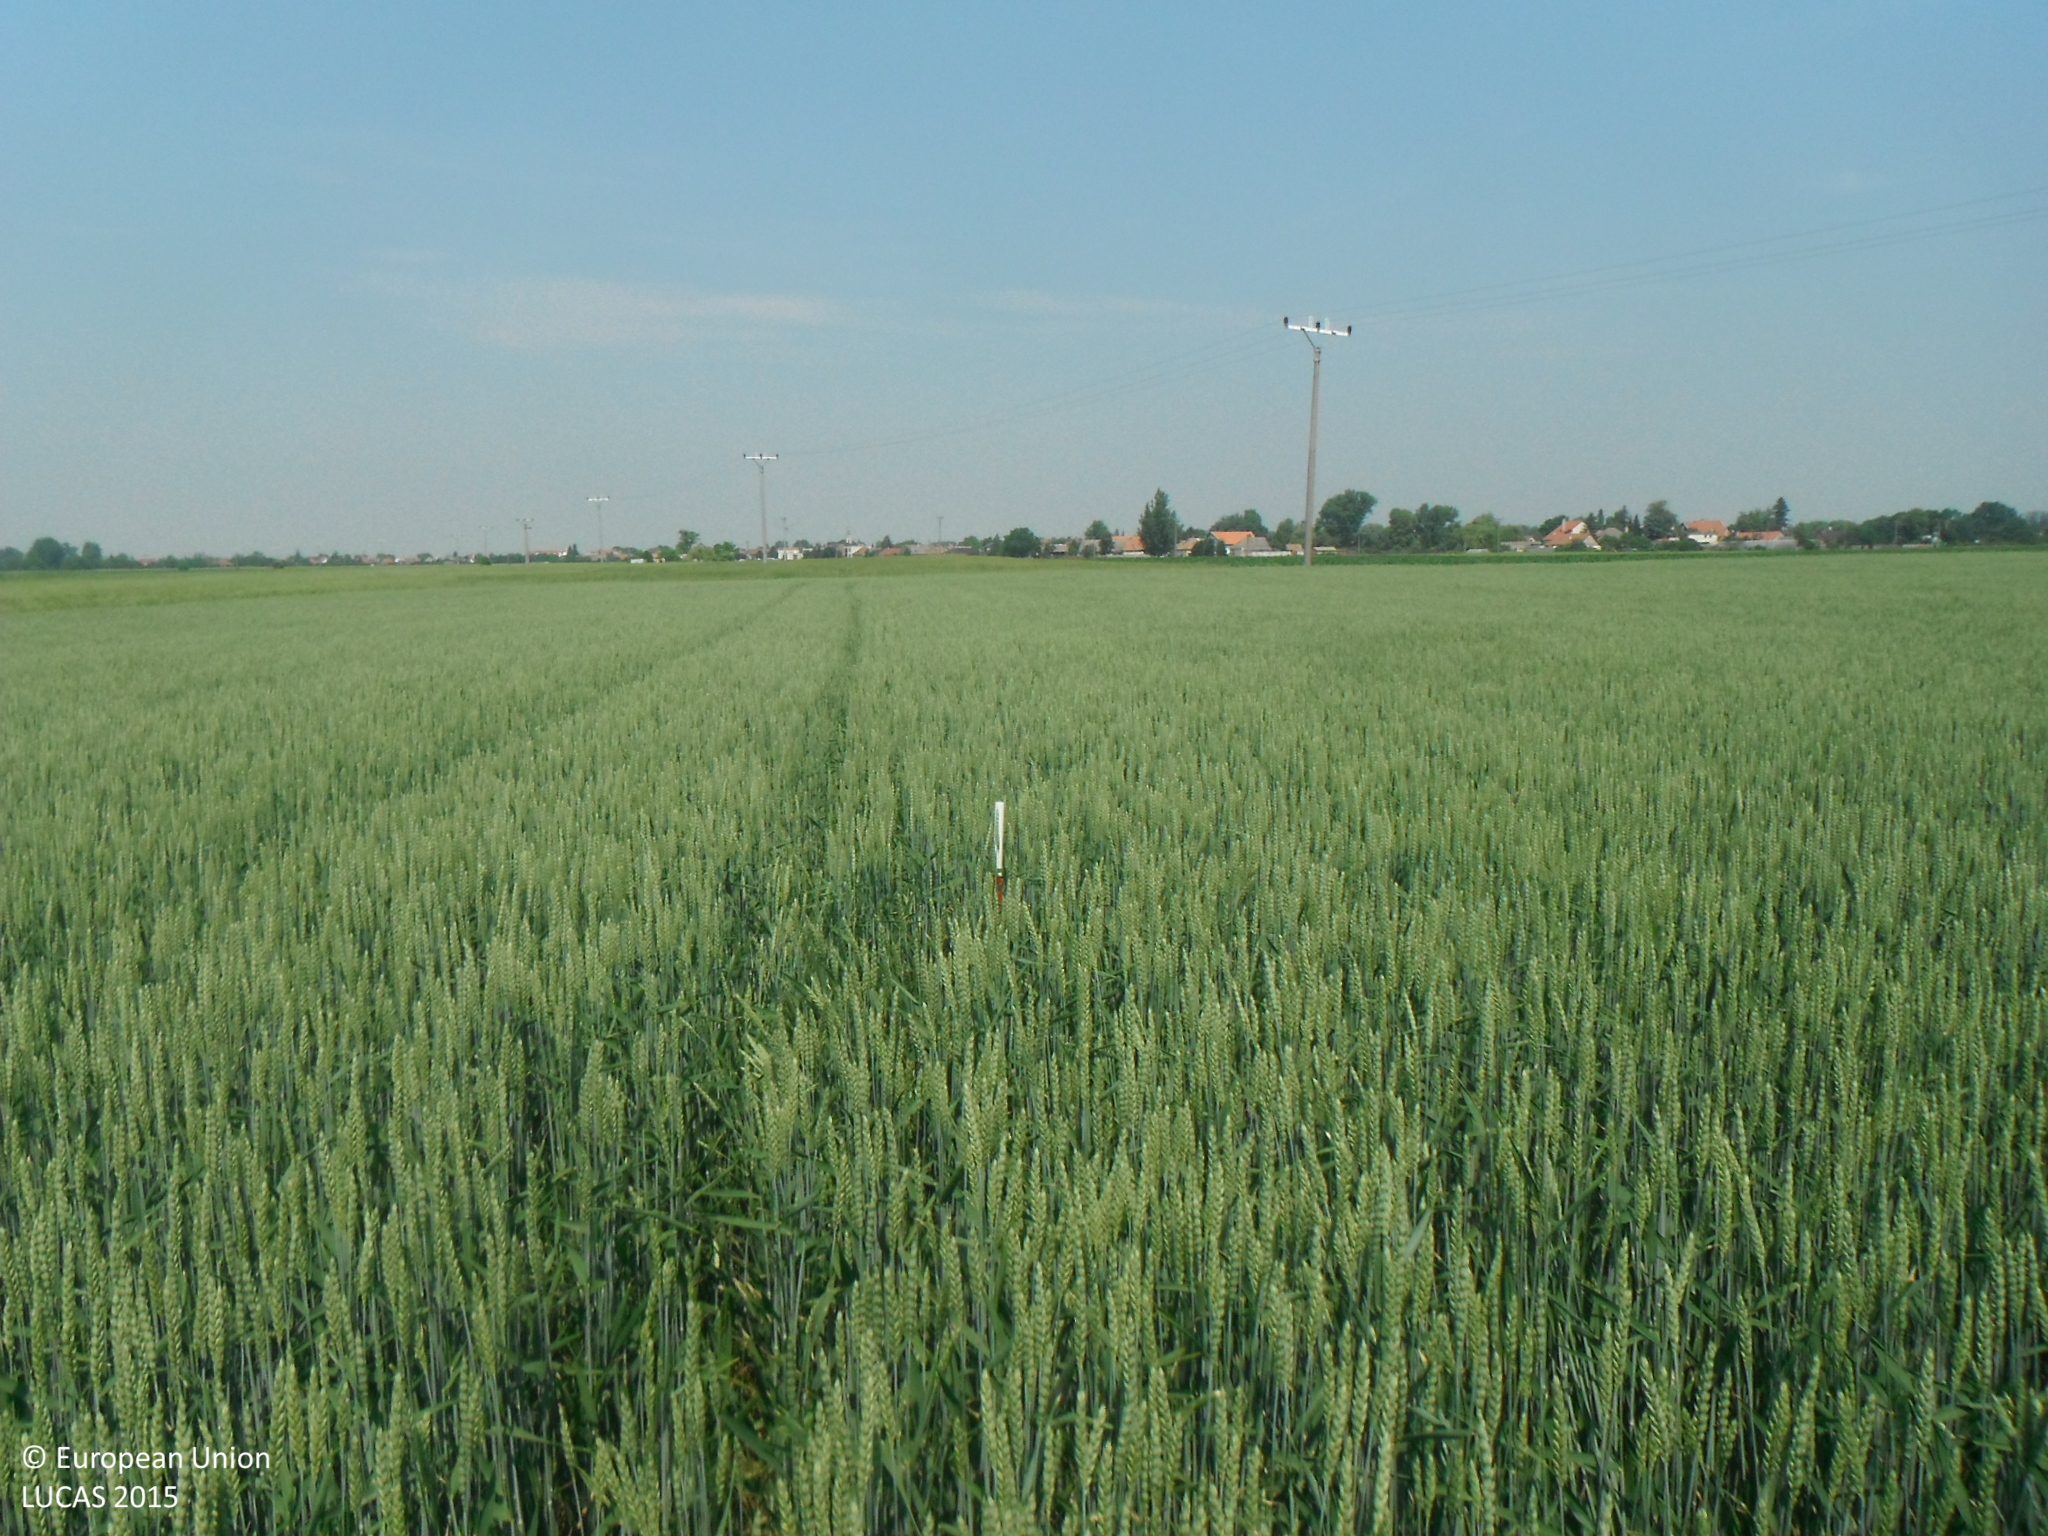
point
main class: Cropland
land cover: Common wheat
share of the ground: > 75 %
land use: Agriculture (excluding fallow land and kitchen gardens)
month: June
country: SK
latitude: 48.1124
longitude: 17.7613
